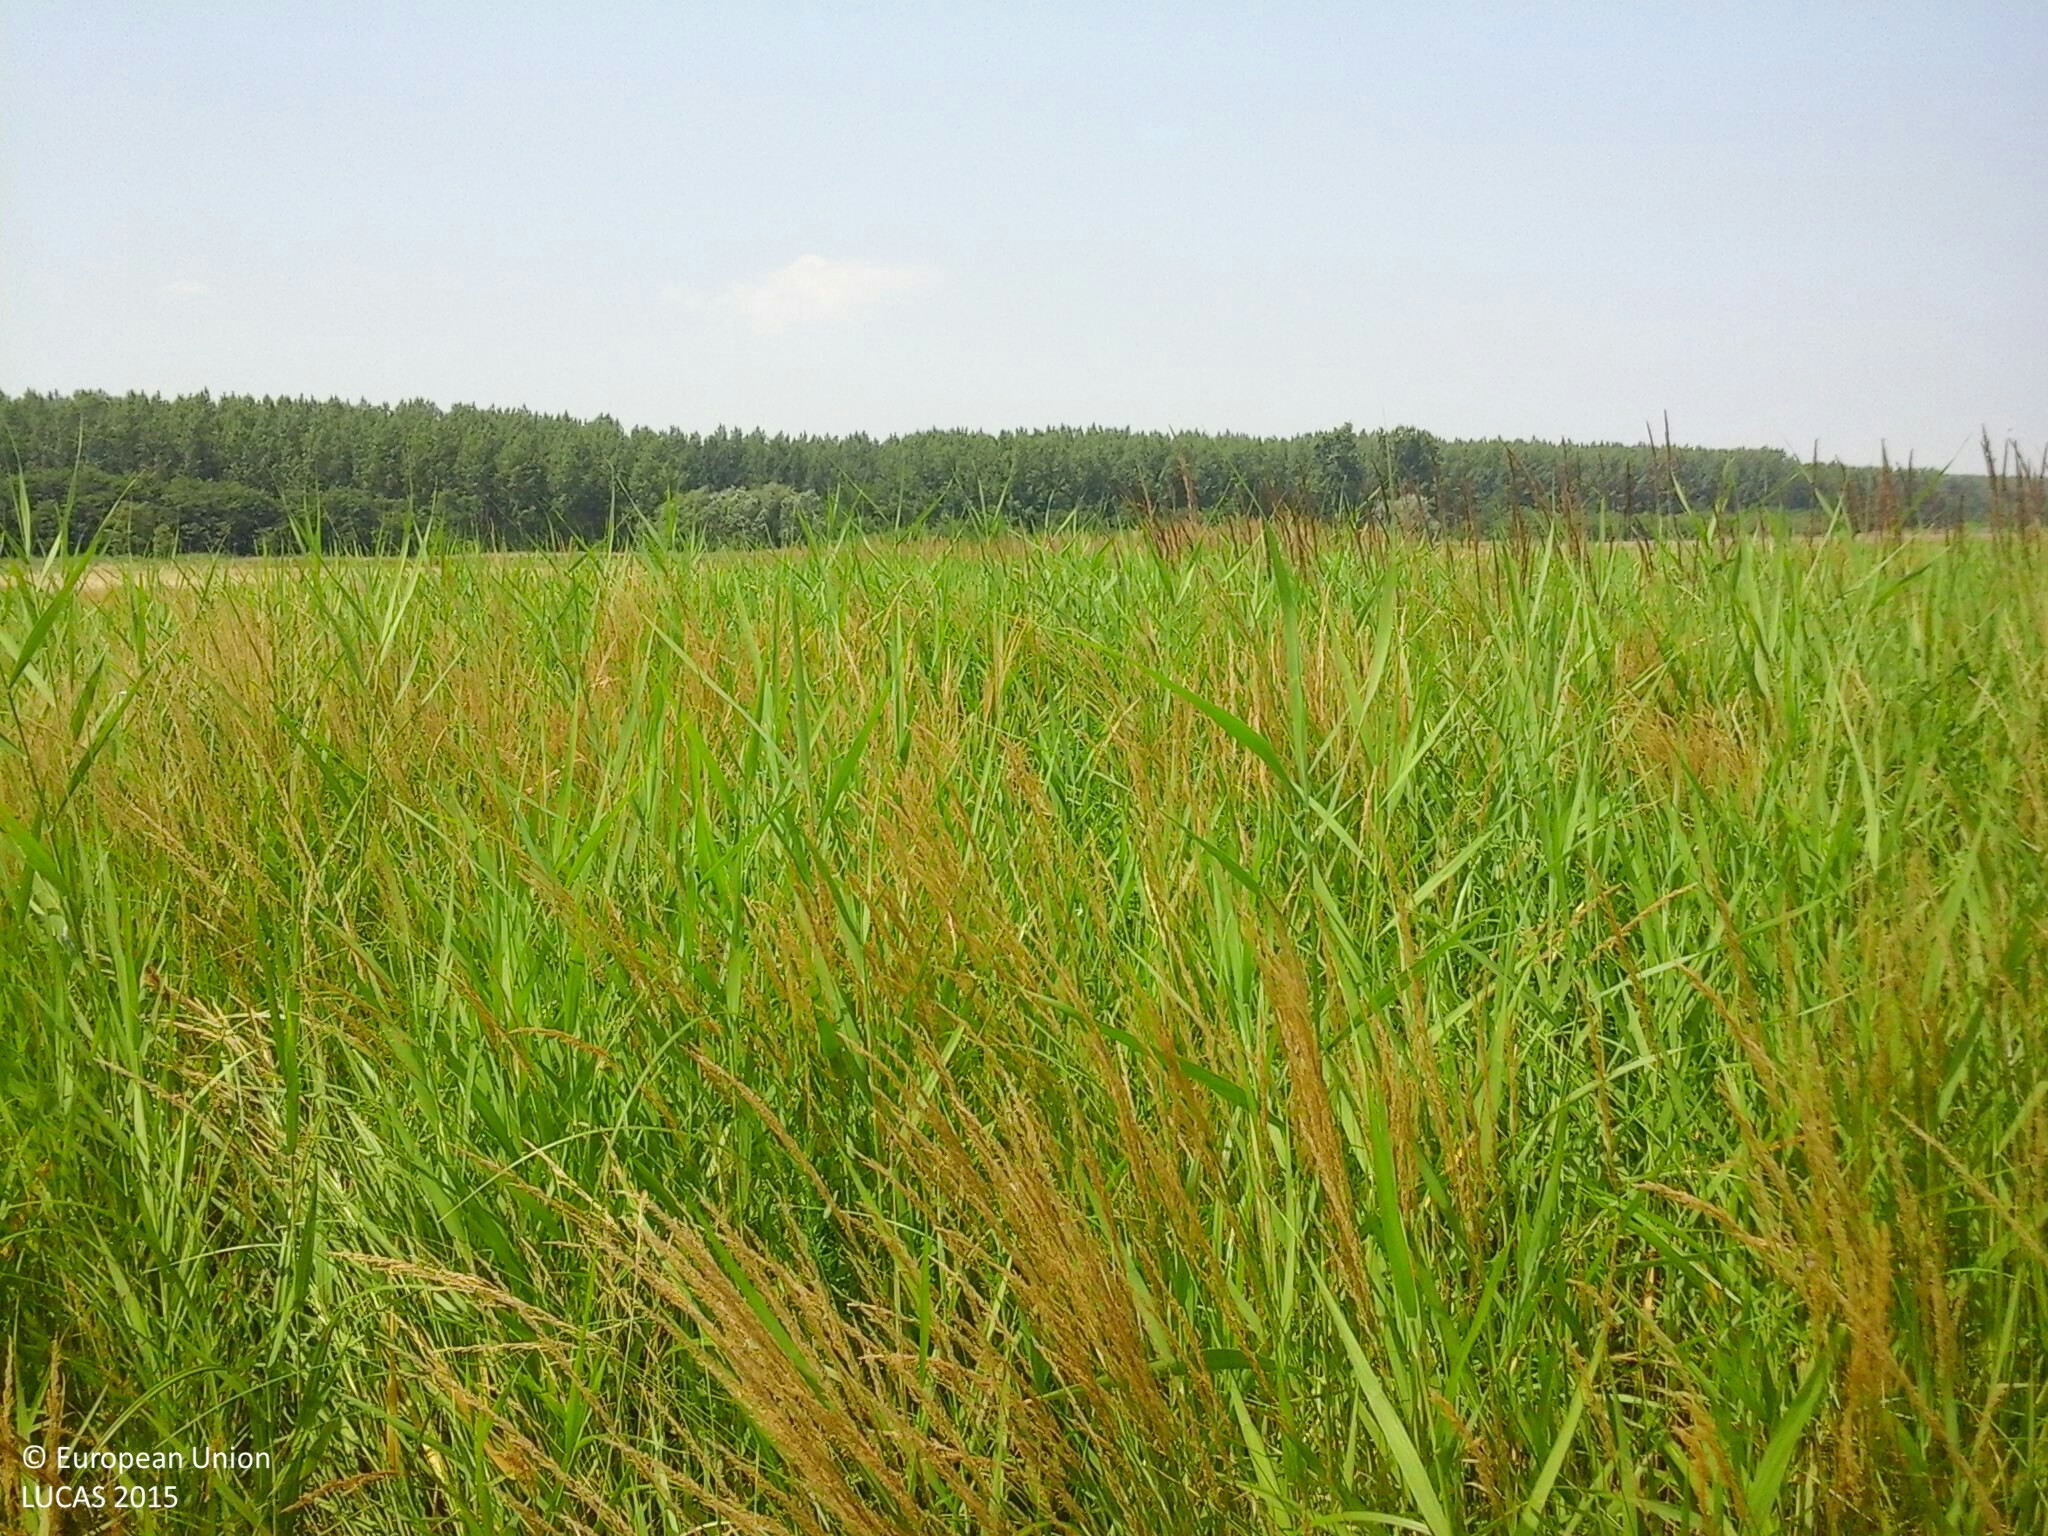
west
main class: Grassland
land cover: Grassland without tree/shrub cover
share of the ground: > 75 %
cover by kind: herbaceous plants 100 %
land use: Agriculture (excluding fallow land and kitchen gardens)
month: July
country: HU
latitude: 46.8434
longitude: 20.1875
